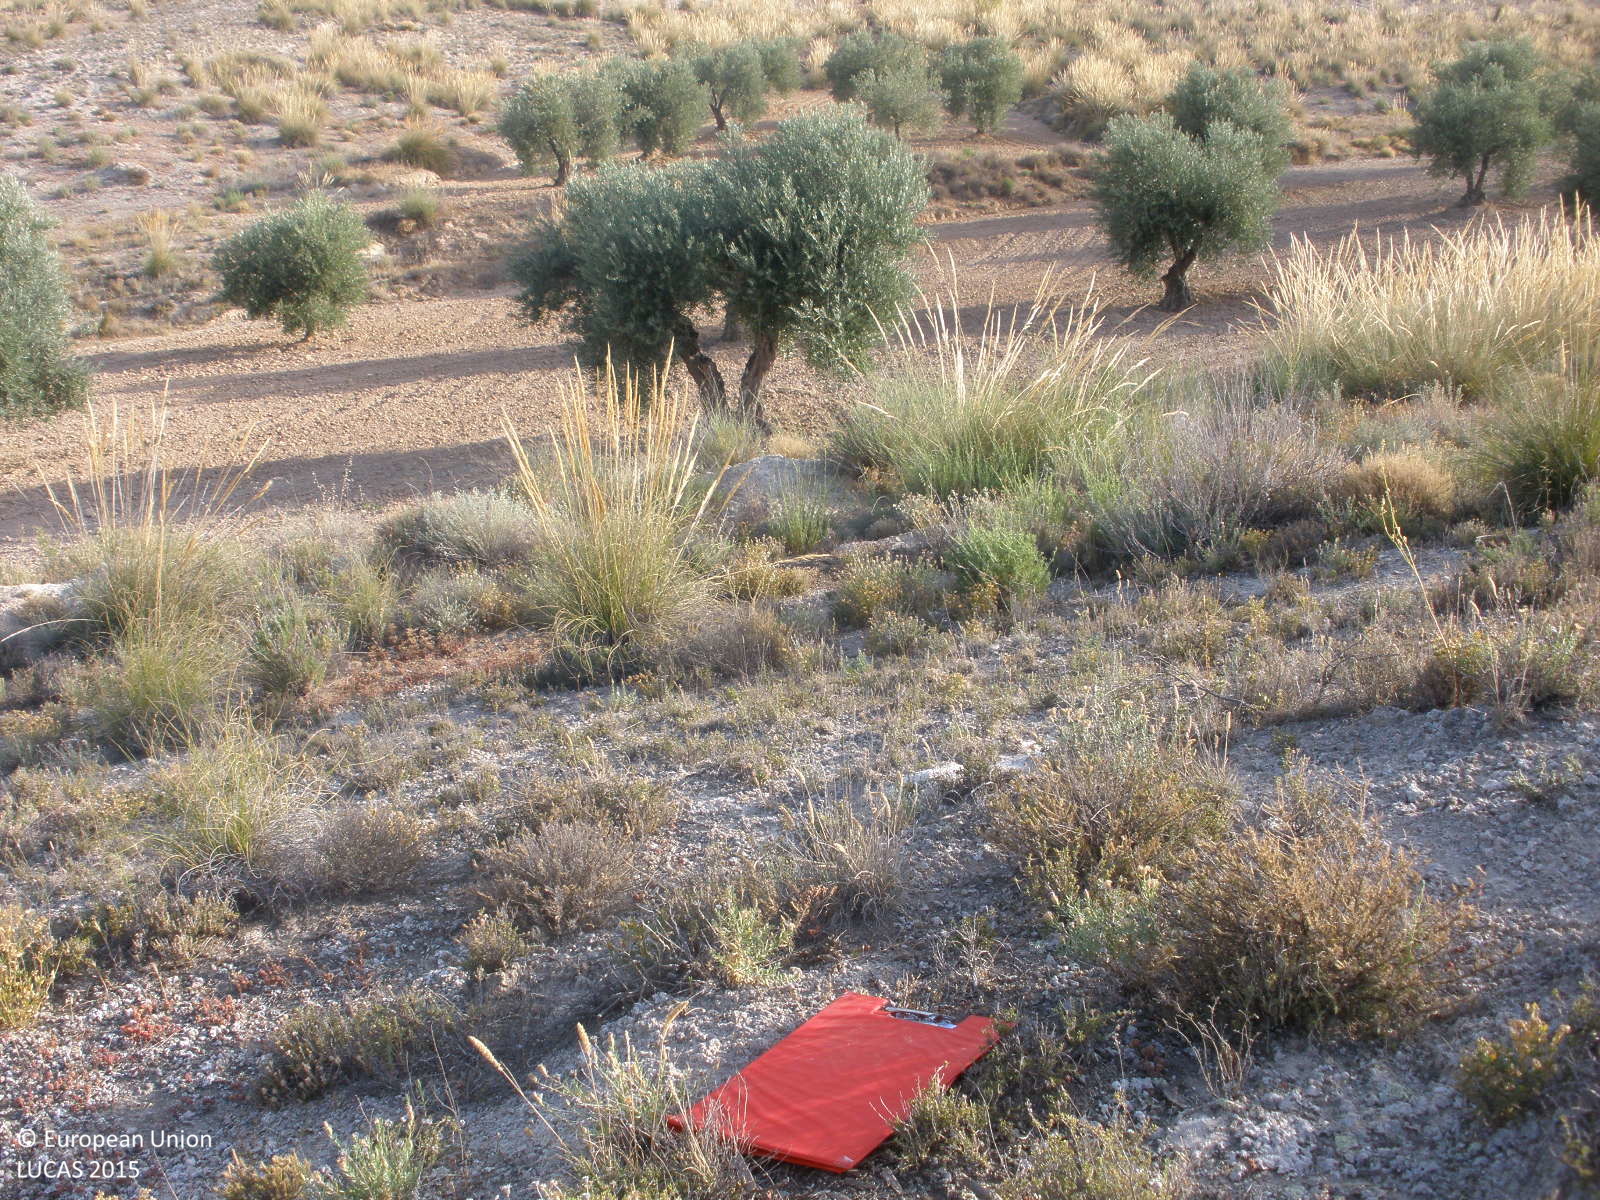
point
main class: Shrubland
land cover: Shrubland without tree cover
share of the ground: 25 - 50 %
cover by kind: shrubs 40 %, herbaceous plants 40 %, consolidated bare surface 20 %
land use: Semi-natural and natural areas not in use
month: July
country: ES
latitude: 40.0150
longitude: -3.4436
